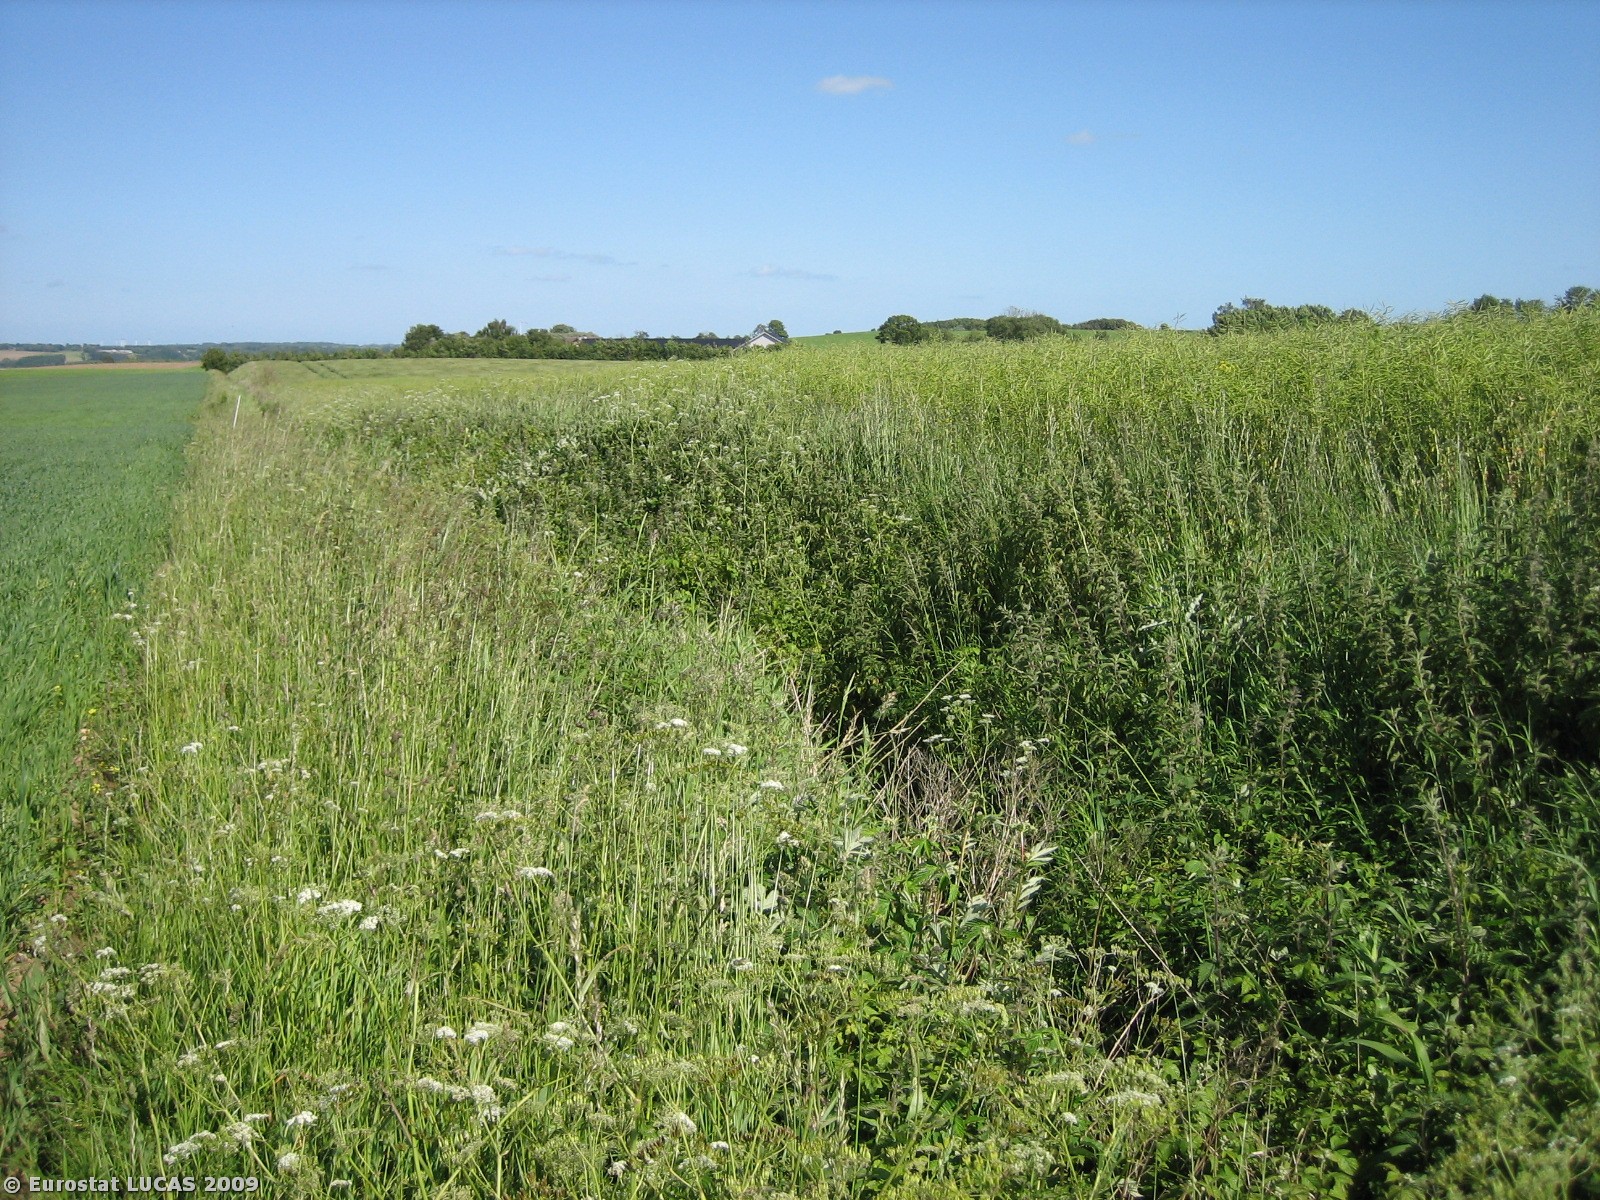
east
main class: Cropland
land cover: Rape and turnip rape
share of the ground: > 75 %
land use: Agriculture (excluding fallow land and kitchen gardens)
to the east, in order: Rape and turnip rape
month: June
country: DK
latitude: 55.8998
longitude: 9.7284
